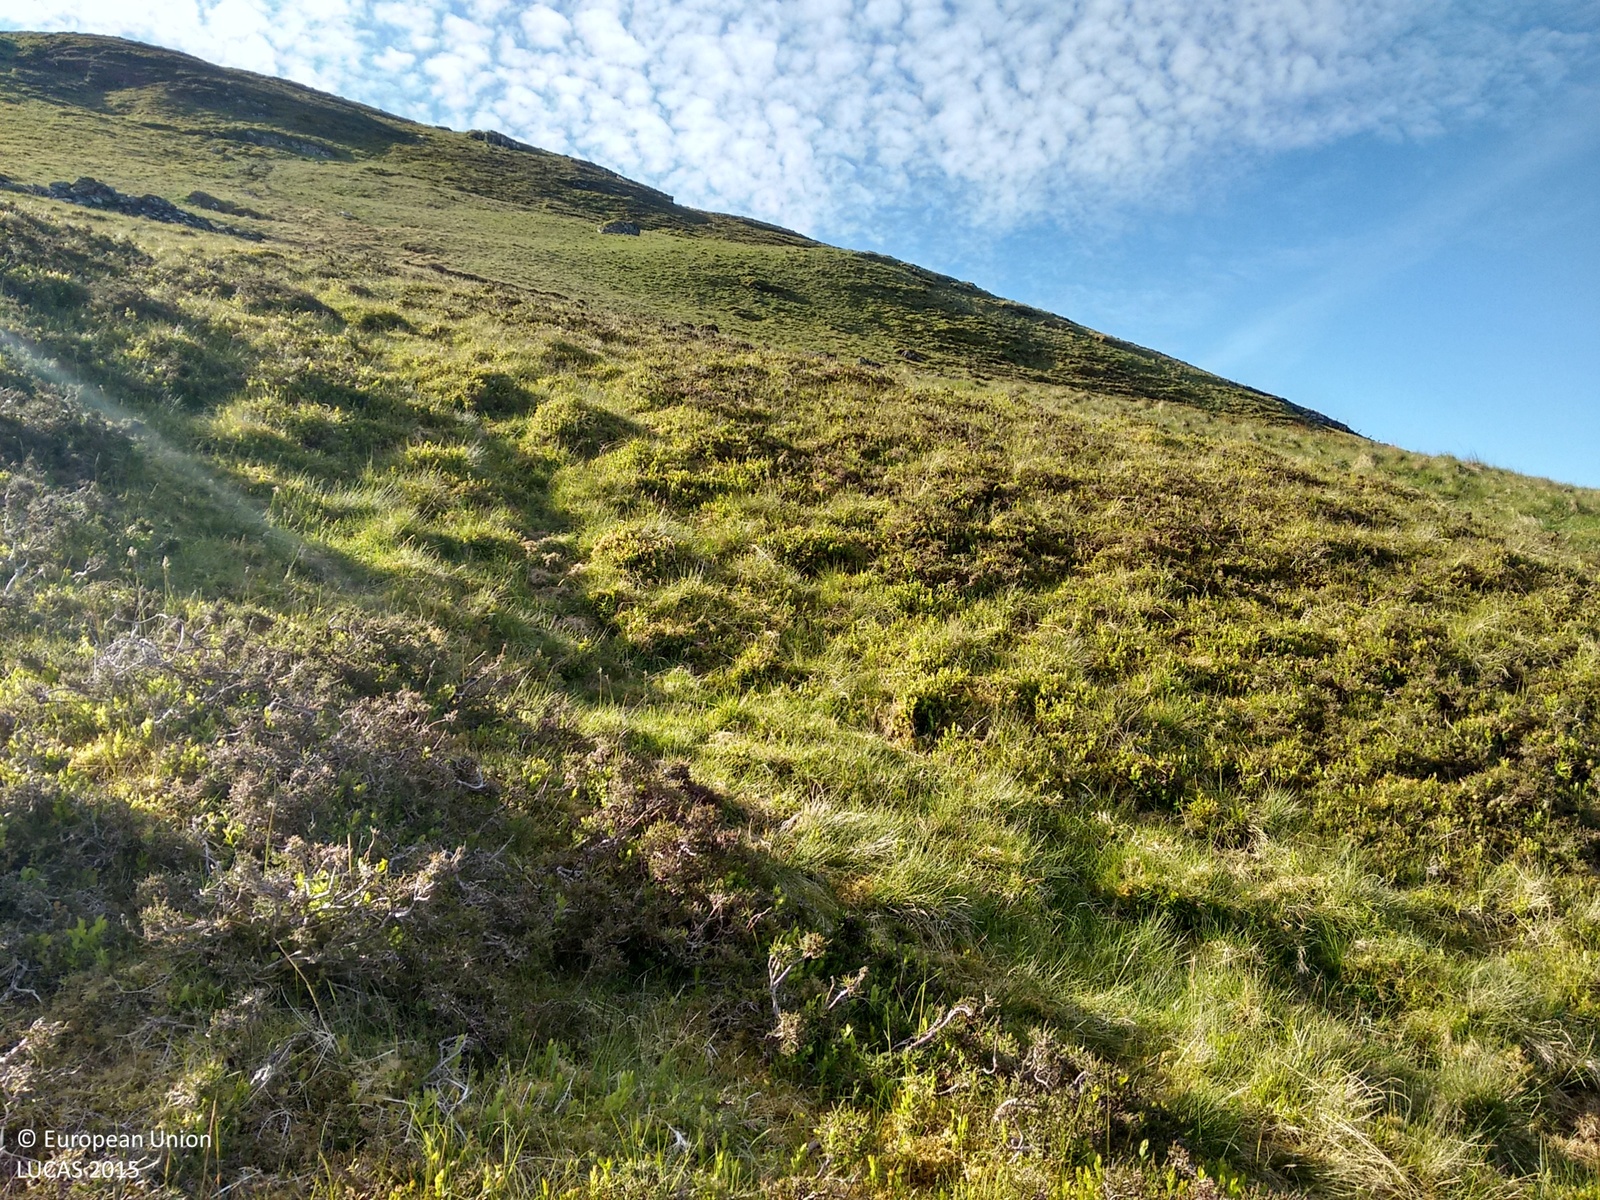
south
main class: Grassland
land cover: Grassland without tree/shrub cover
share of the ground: > 75 %
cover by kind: herbaceous plants 90 %, shrubs 5 %
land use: Agriculture (excluding fallow land and kitchen gardens)
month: June
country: GB
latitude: 56.5178
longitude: -4.1137
